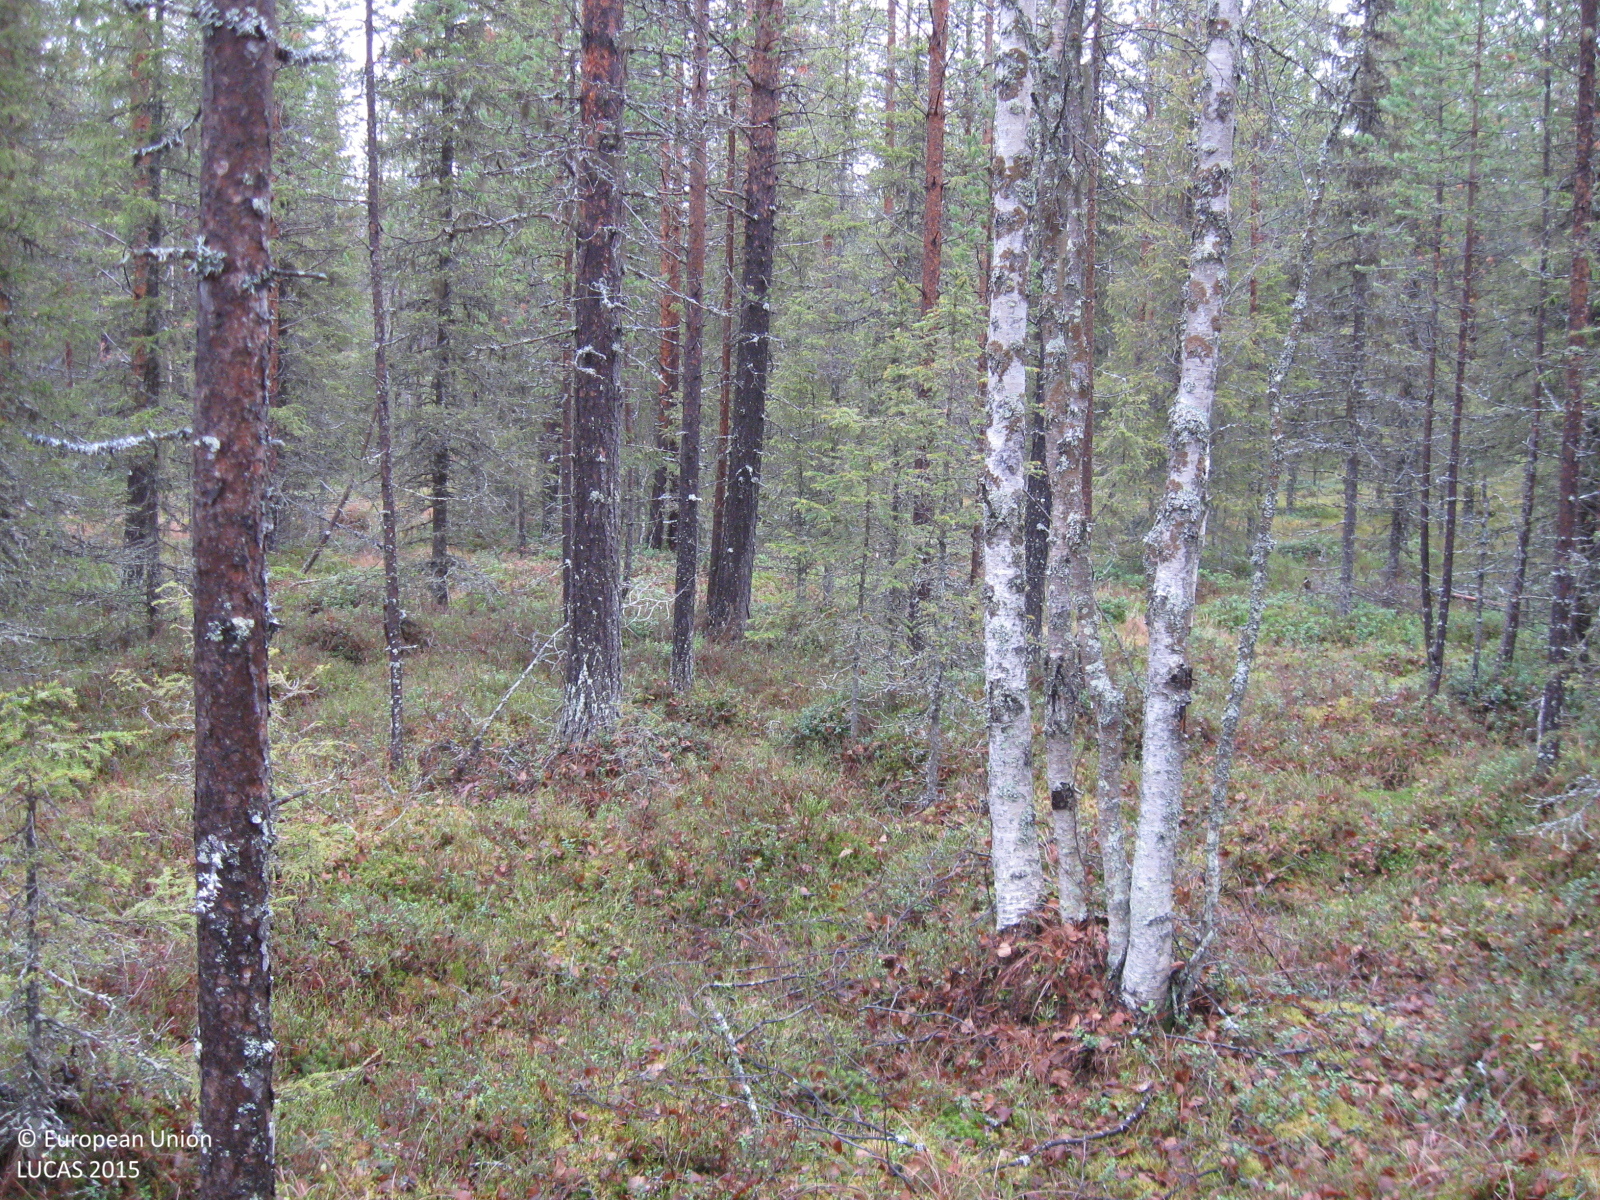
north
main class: Woodland
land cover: Other coniferous woodland
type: boreal forest
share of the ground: > 75 %
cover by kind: coniferous forest trees 70 %, broadleaved forest trees 10 %, shrubs 10 %, herbaceous plants 5 %, lichens and mosses 5 %
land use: Forestry
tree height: > 5 m
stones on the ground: 10 - 25 %
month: October
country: SE
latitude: 66.6926
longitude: 21.7167
